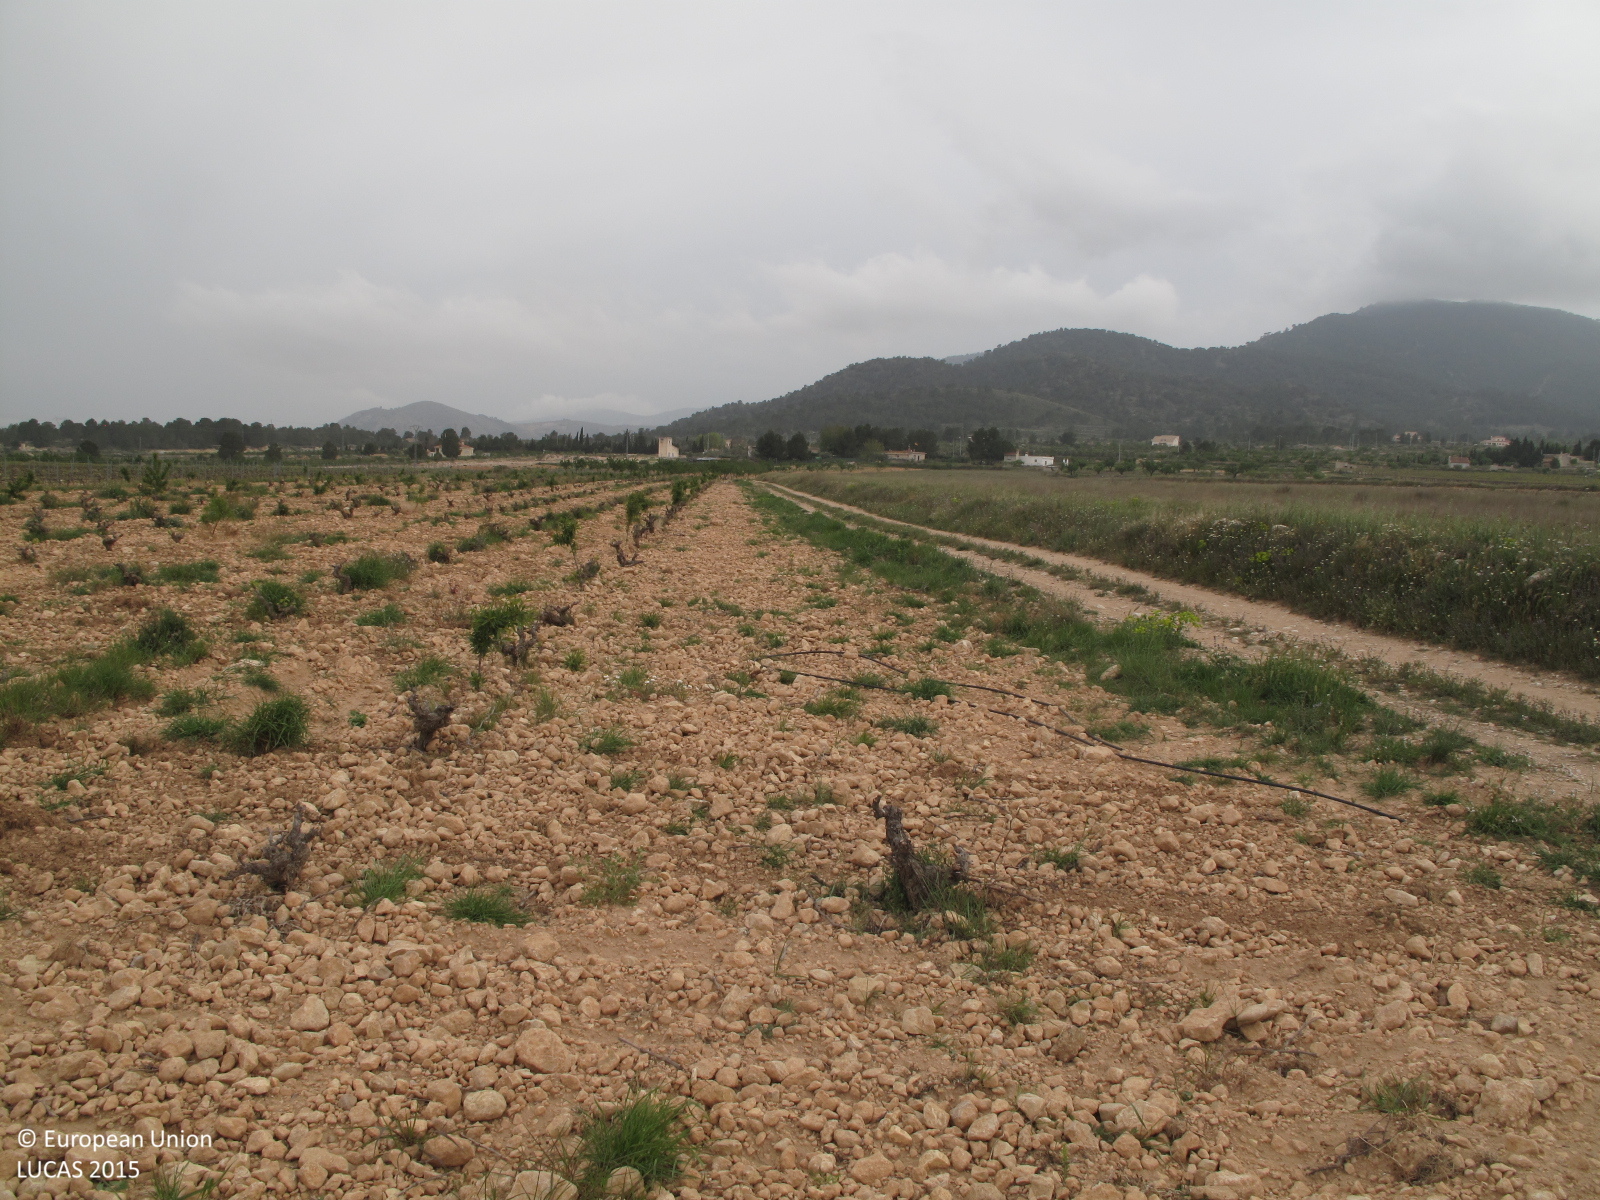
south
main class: Cropland
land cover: Vineyards
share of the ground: < 10 %
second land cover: Nuts trees
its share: < 10 %
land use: Agriculture (excluding fallow land and kitchen gardens)
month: April
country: ES
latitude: 38.4139
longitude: -0.9254
